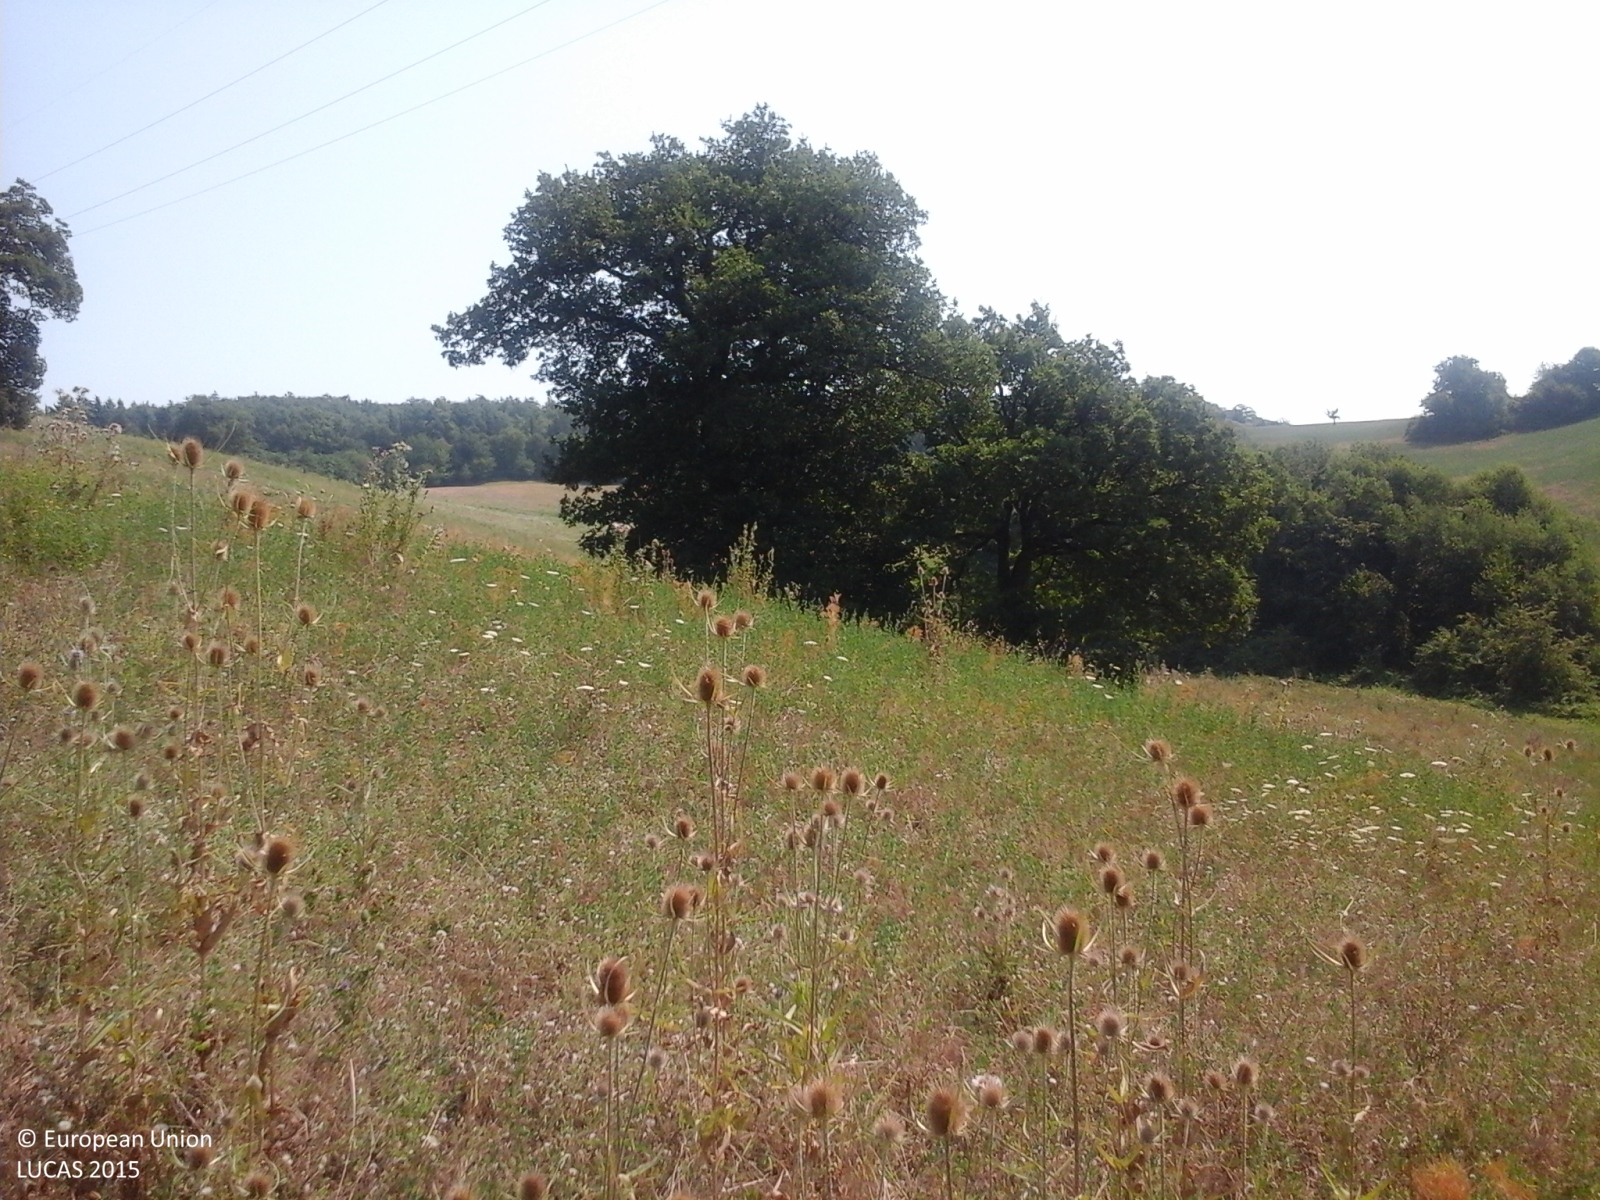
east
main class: Shrubland
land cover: Shrubland with sparse tree cover
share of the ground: > 75 %
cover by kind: shrubs 95 %, broadleaved forest trees 5 %
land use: Semi-natural and natural areas not in use
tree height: > 5 m
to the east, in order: Shrubland with sparse tree cover; Lucerne; Single bushes/trees; Lucerne; Electric lines; Lucerne; Broadleaved woodland; Lucerne
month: August
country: IT
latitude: 43.5532
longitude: 12.8522
